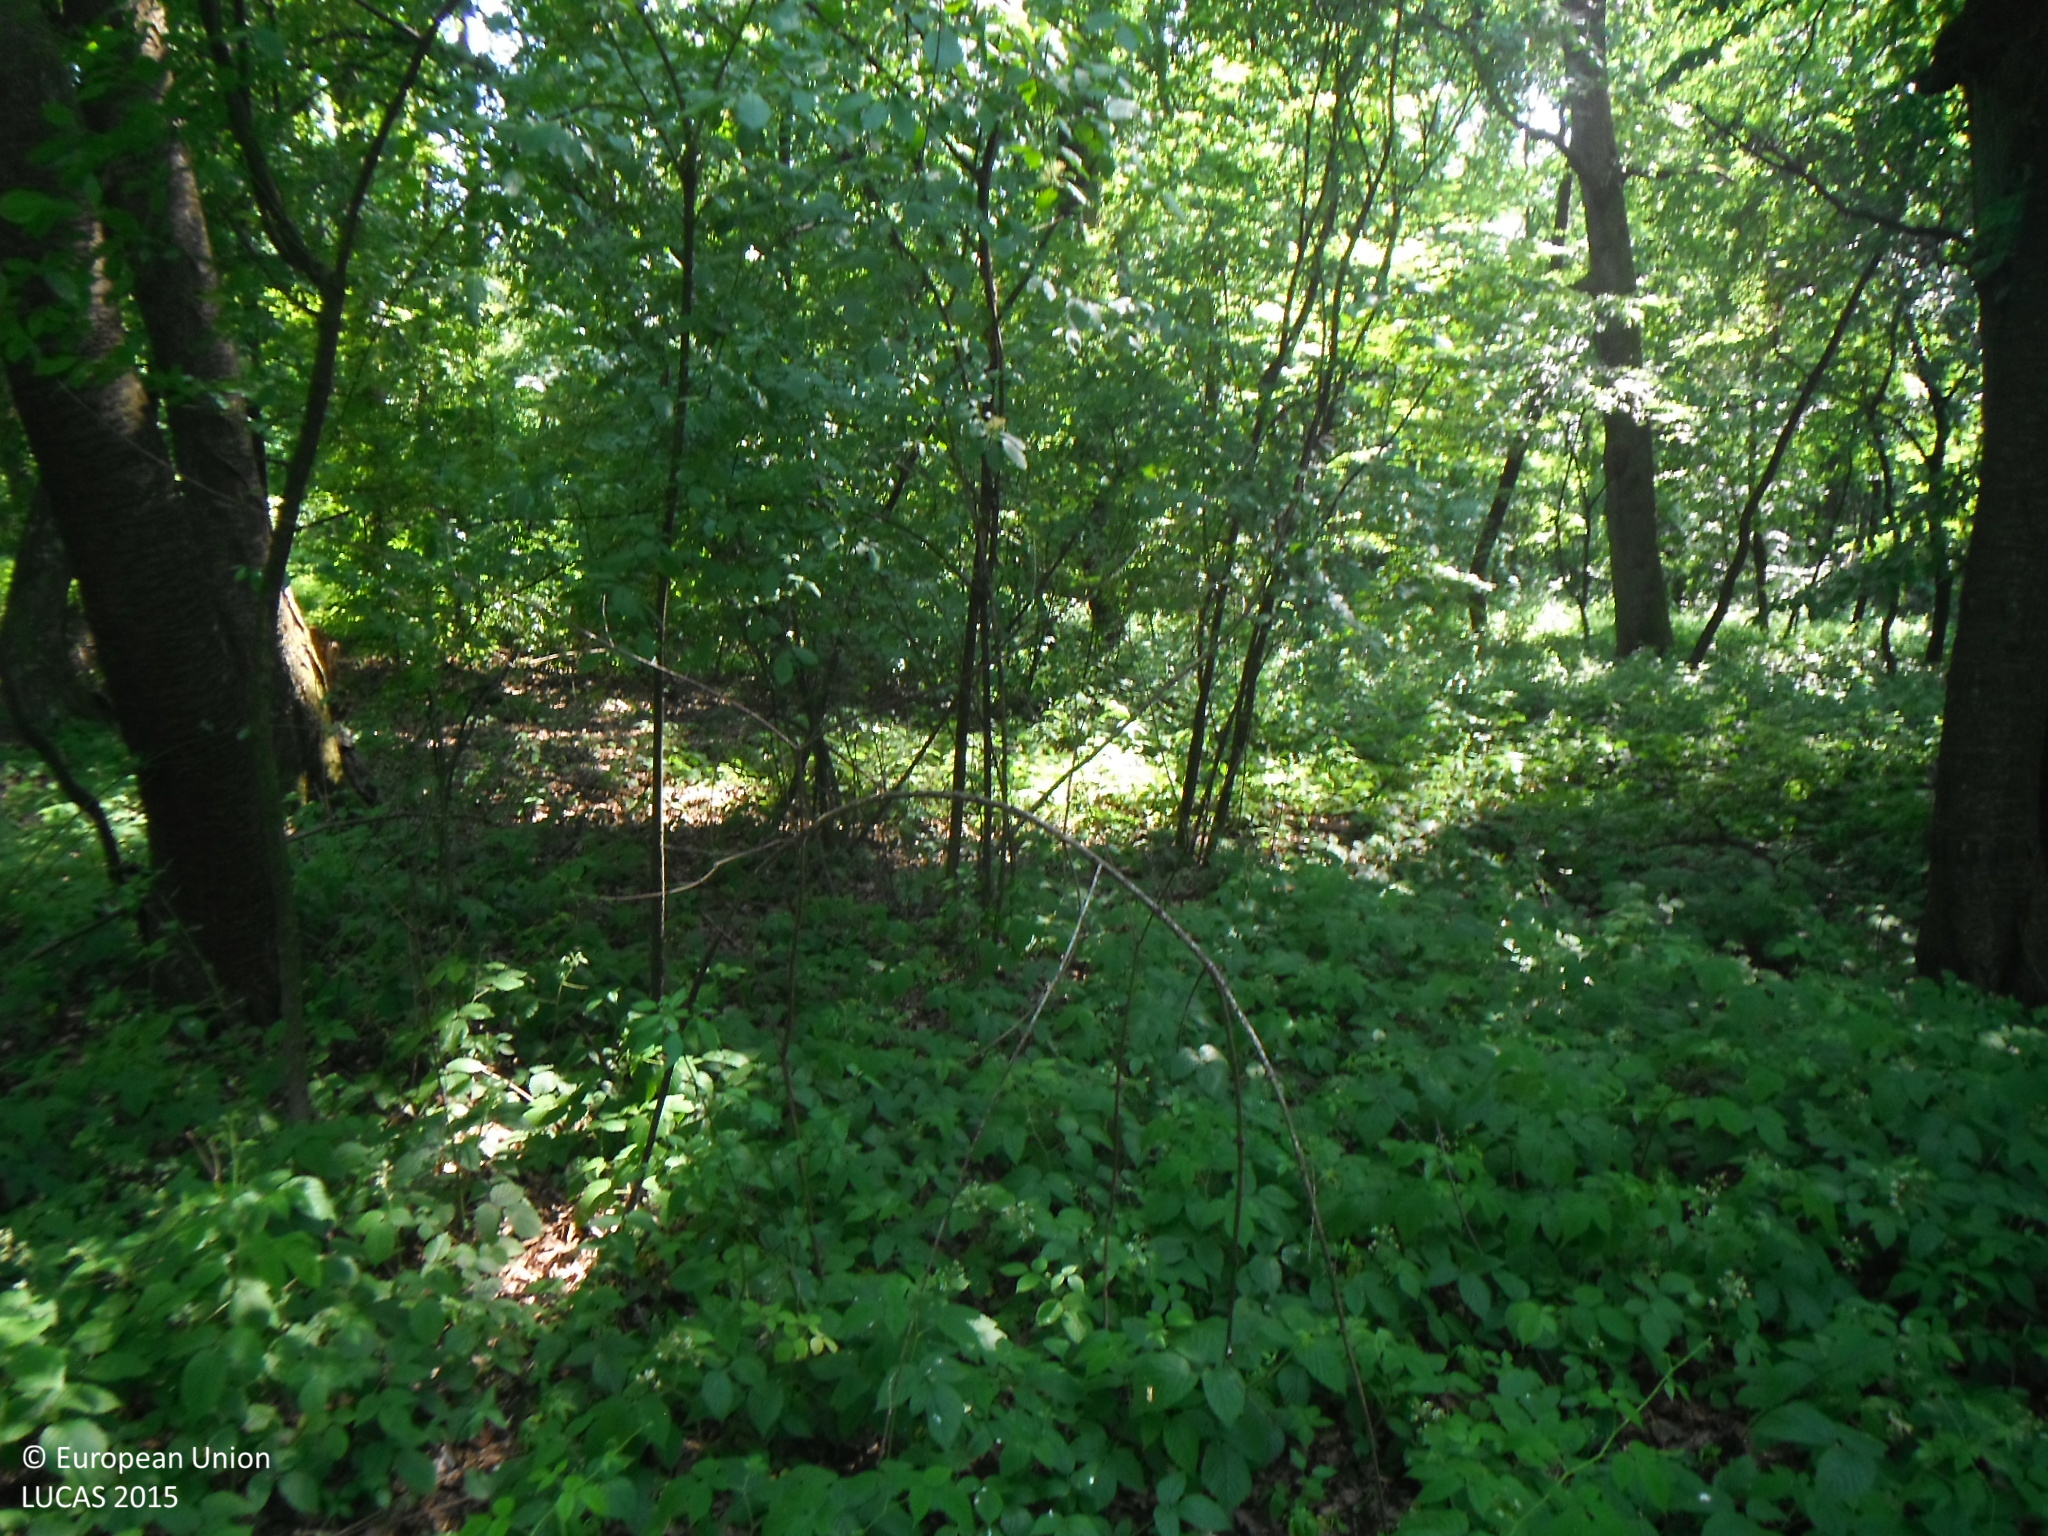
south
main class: Woodland
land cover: Broadleaved woodland
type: beech forest
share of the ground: > 75 %
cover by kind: broadleaved forest trees 80 %, herbaceous plants 20 %
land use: Forestry
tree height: > 5 m
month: June
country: SK
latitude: 48.7730
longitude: 21.9328
